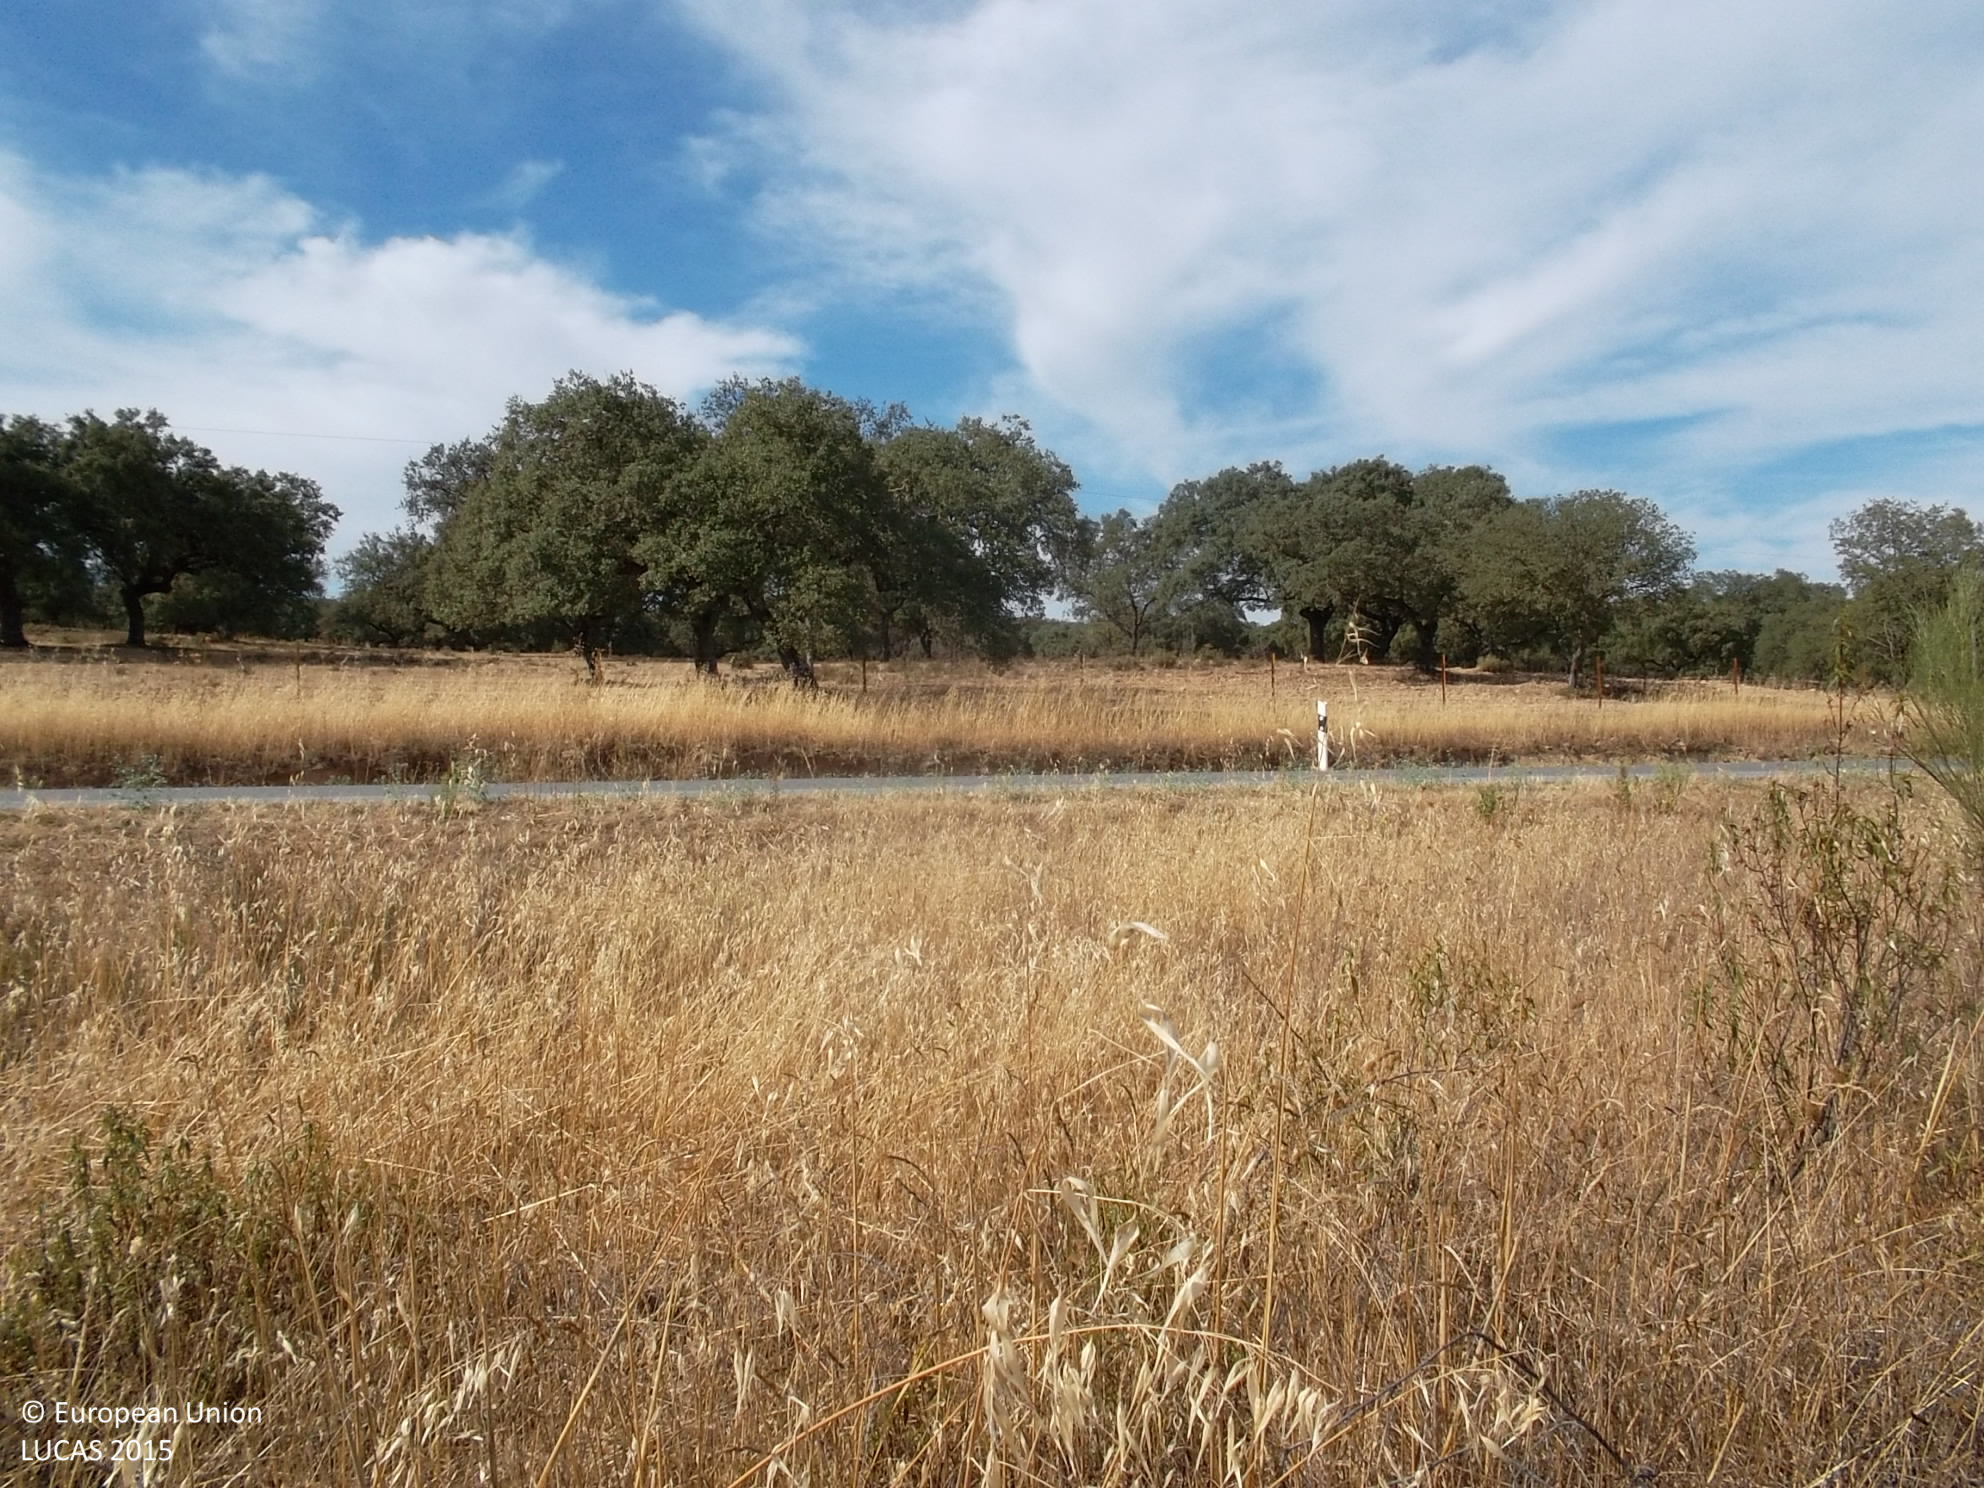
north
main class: Woodland
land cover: Broadleaved woodland
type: broadleaved evergreen forest
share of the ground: 50 - 75 %
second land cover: Grassland without tree/shrub cover
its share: > 75 %
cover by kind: broadleaved forest trees 50 %, herbaceous plants 50 %
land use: Forestry
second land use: Agriculture (excluding fallow land and kitchen gardens)
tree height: > 5 m
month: August
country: ES
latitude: 38.1581
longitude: -6.8184
